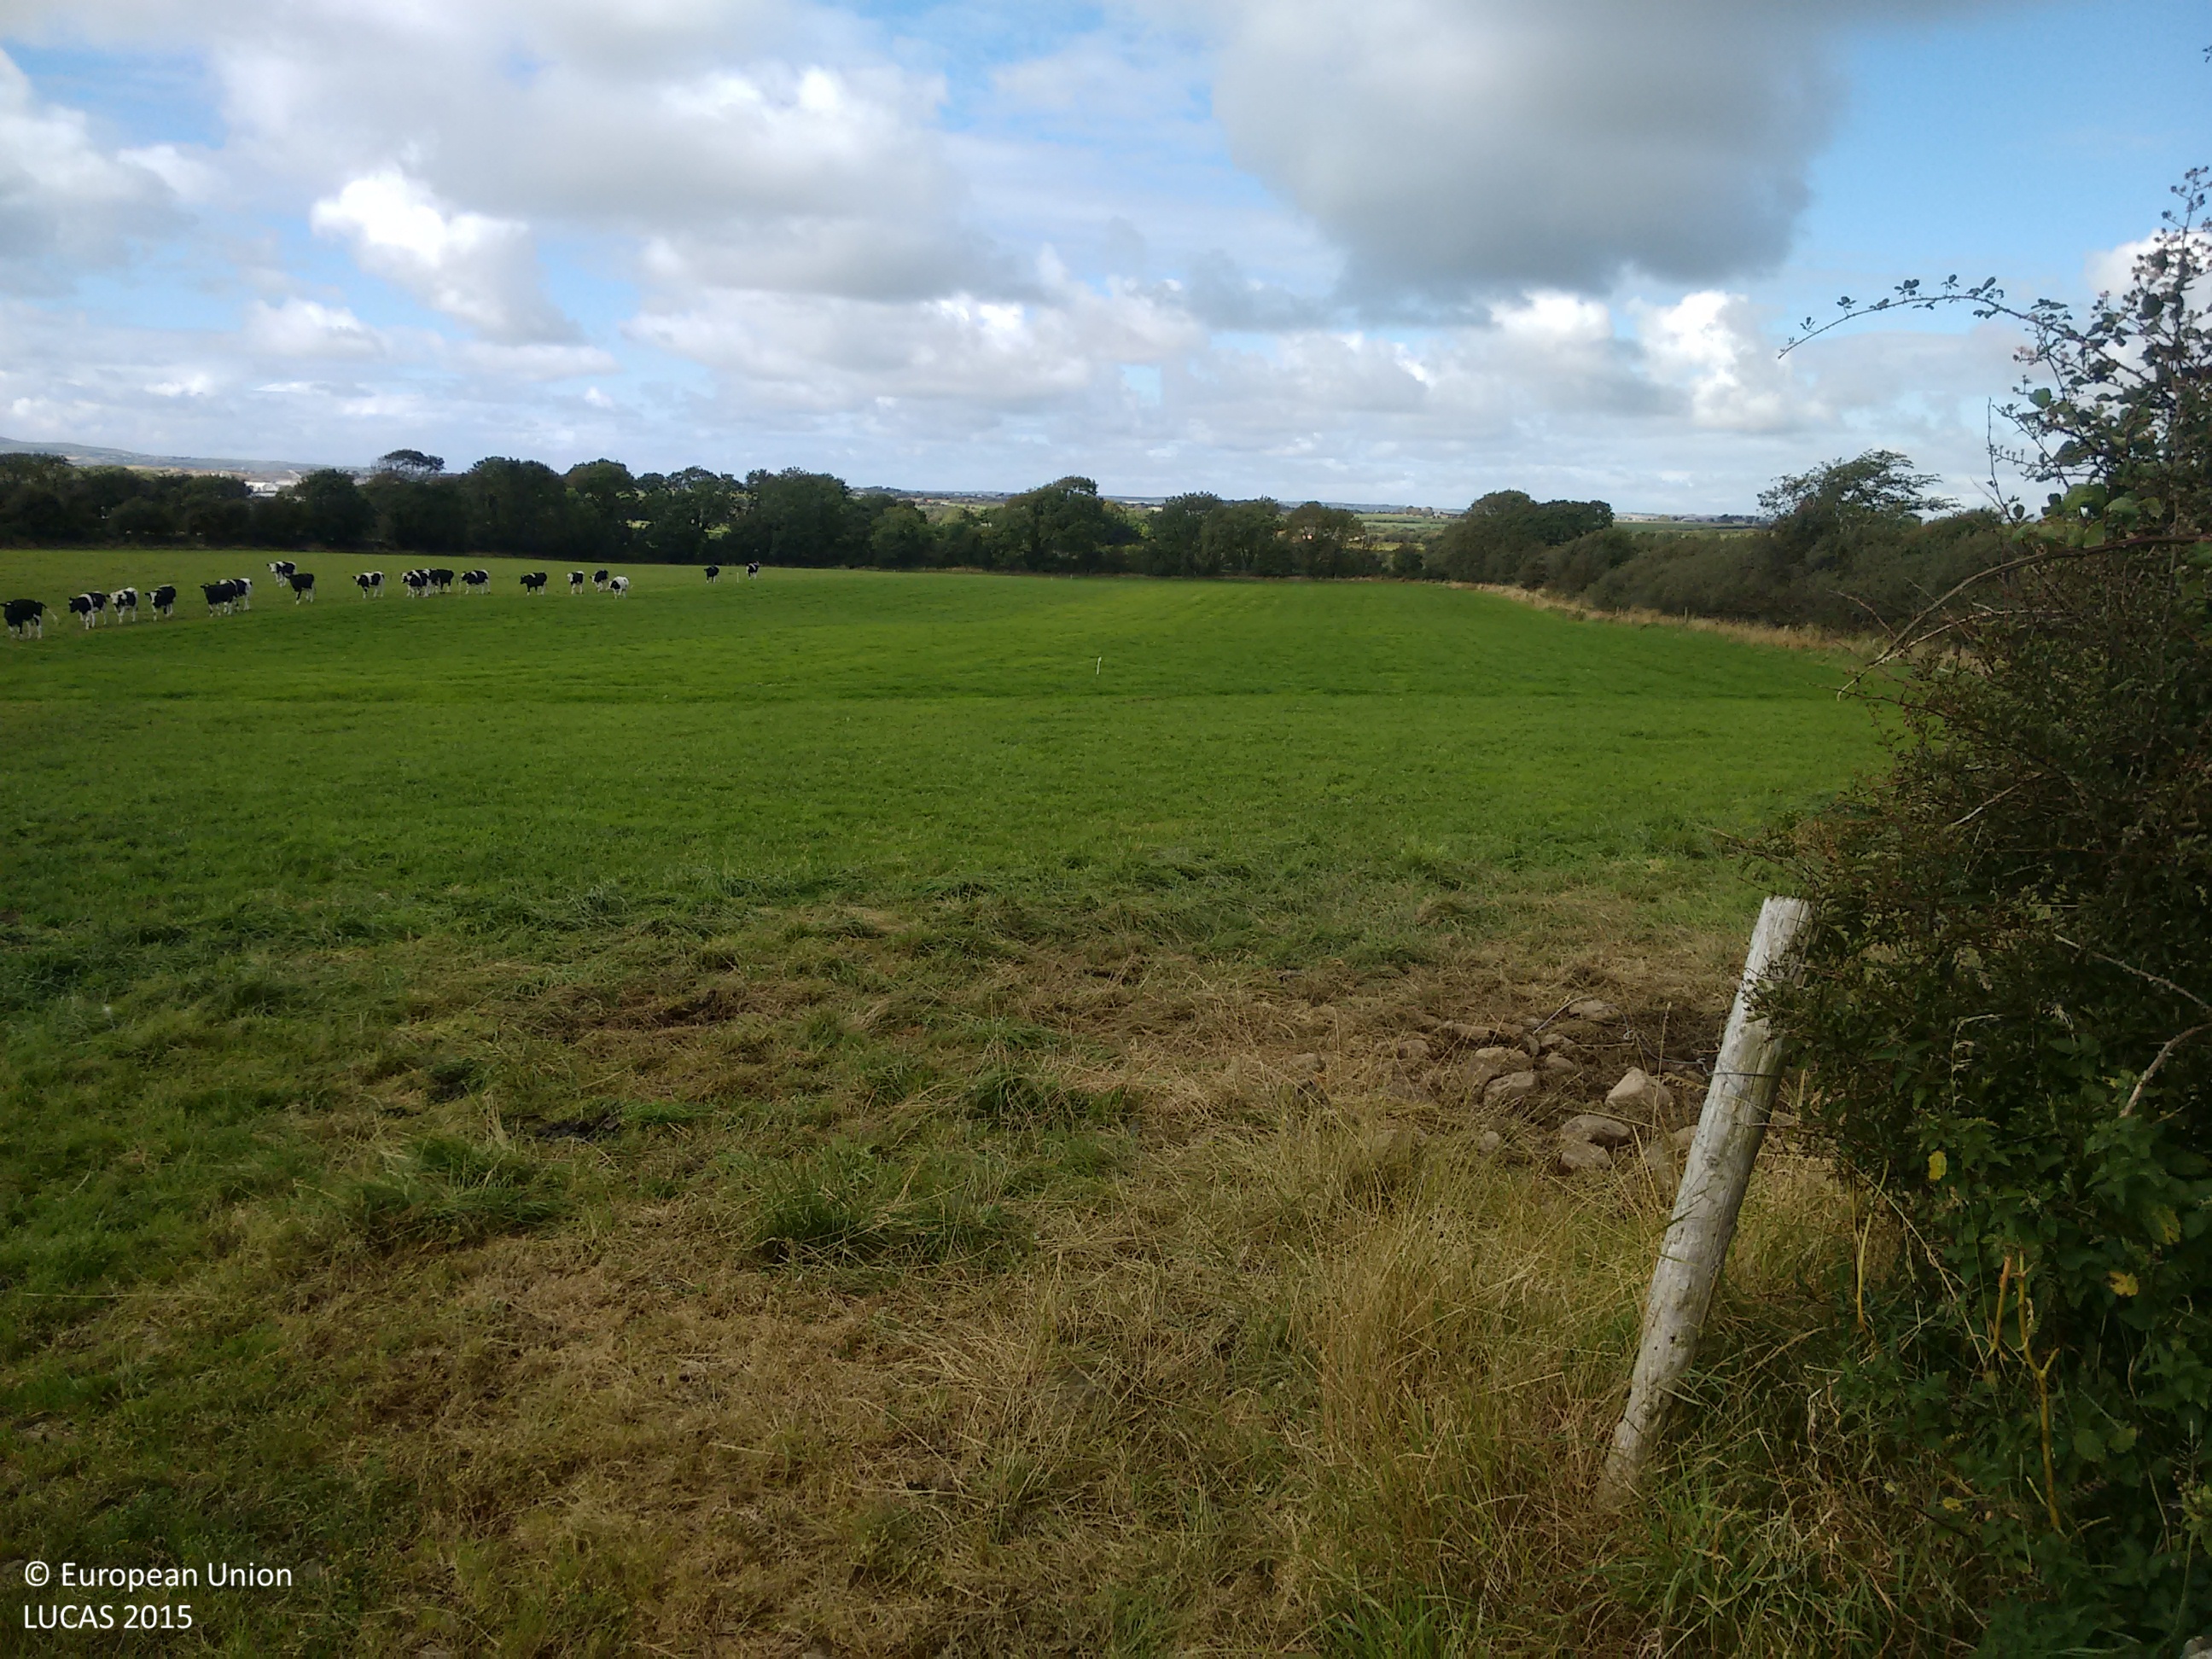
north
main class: Grassland
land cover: Grassland without tree/shrub cover
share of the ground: > 75 %
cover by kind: herbaceous plants 100 %
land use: Agriculture (excluding fallow land and kitchen gardens)
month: September
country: IE
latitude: 52.3261
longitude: -9.7435
